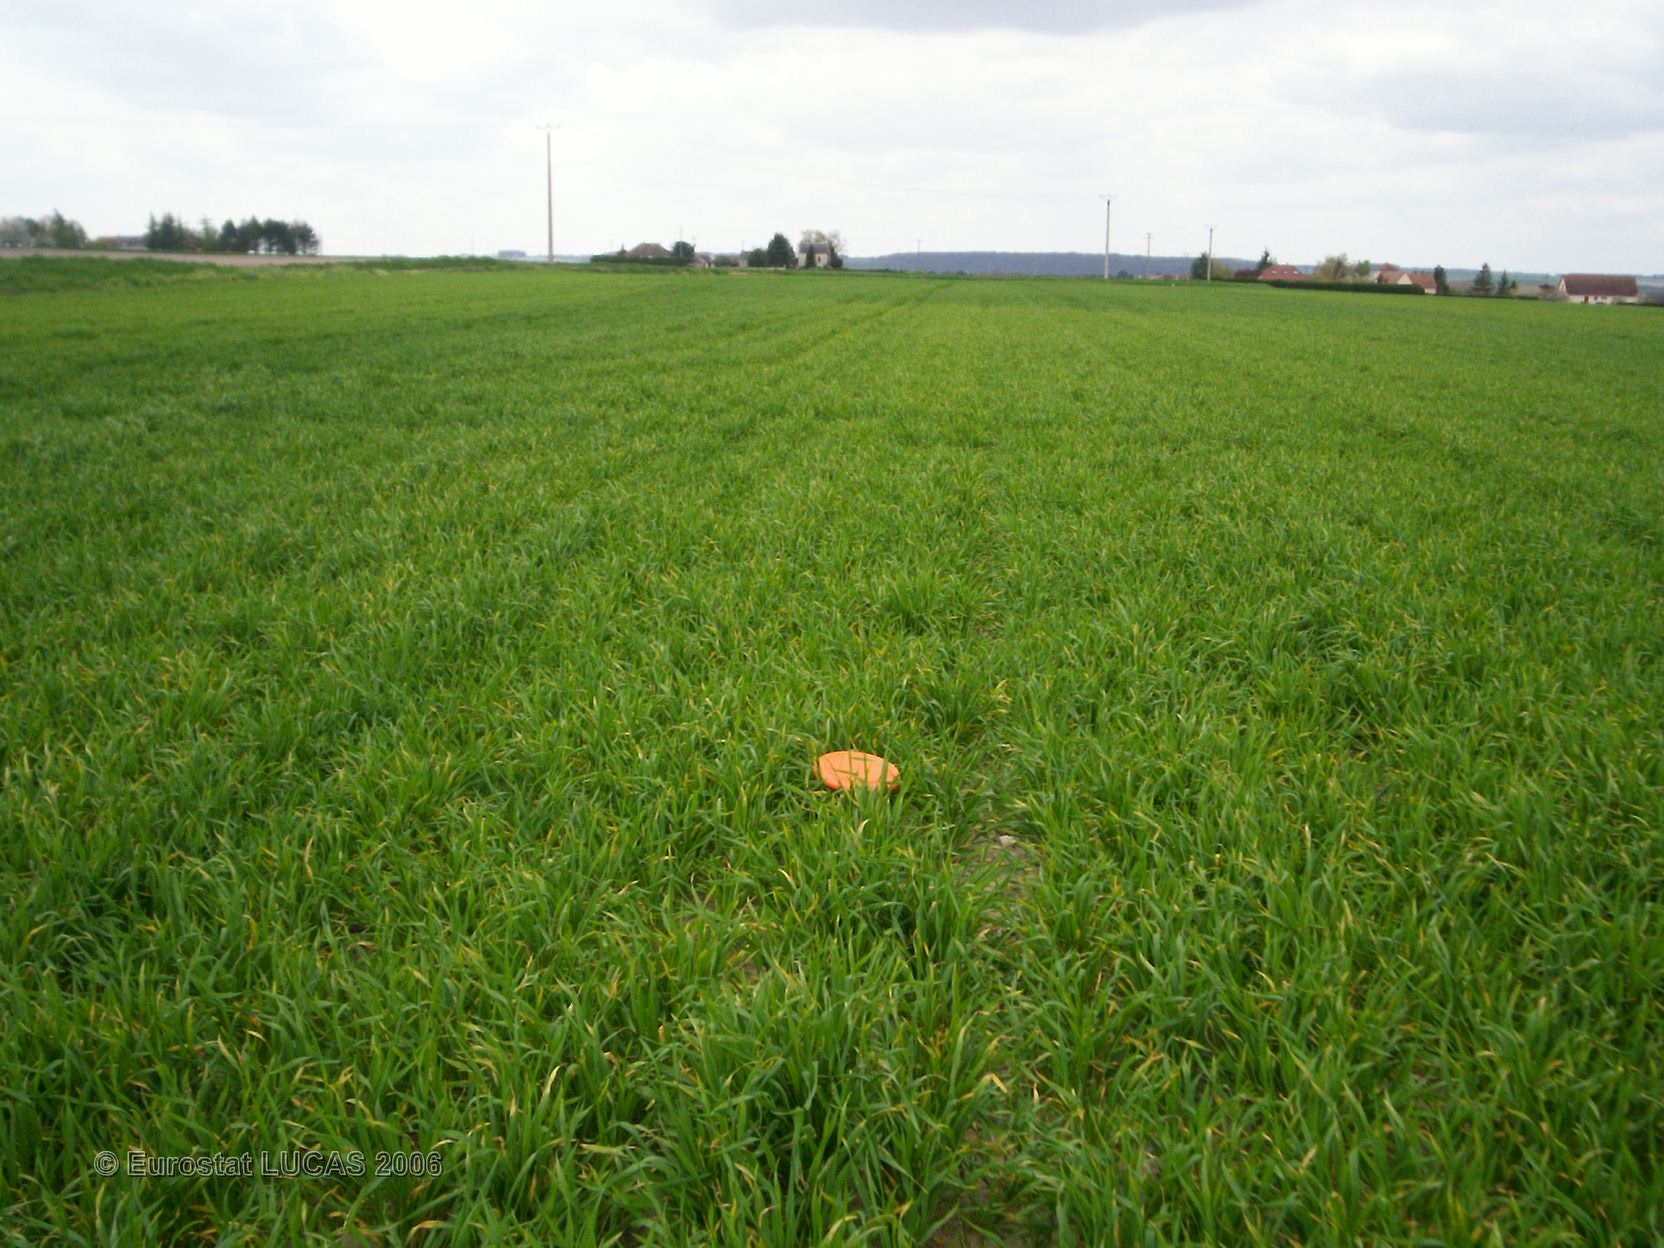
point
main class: Cropland
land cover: Common wheat
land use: Agriculture (excluding fallow land and kitchen gardens)
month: April
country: FR
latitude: 47.0418
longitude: 0.5971
